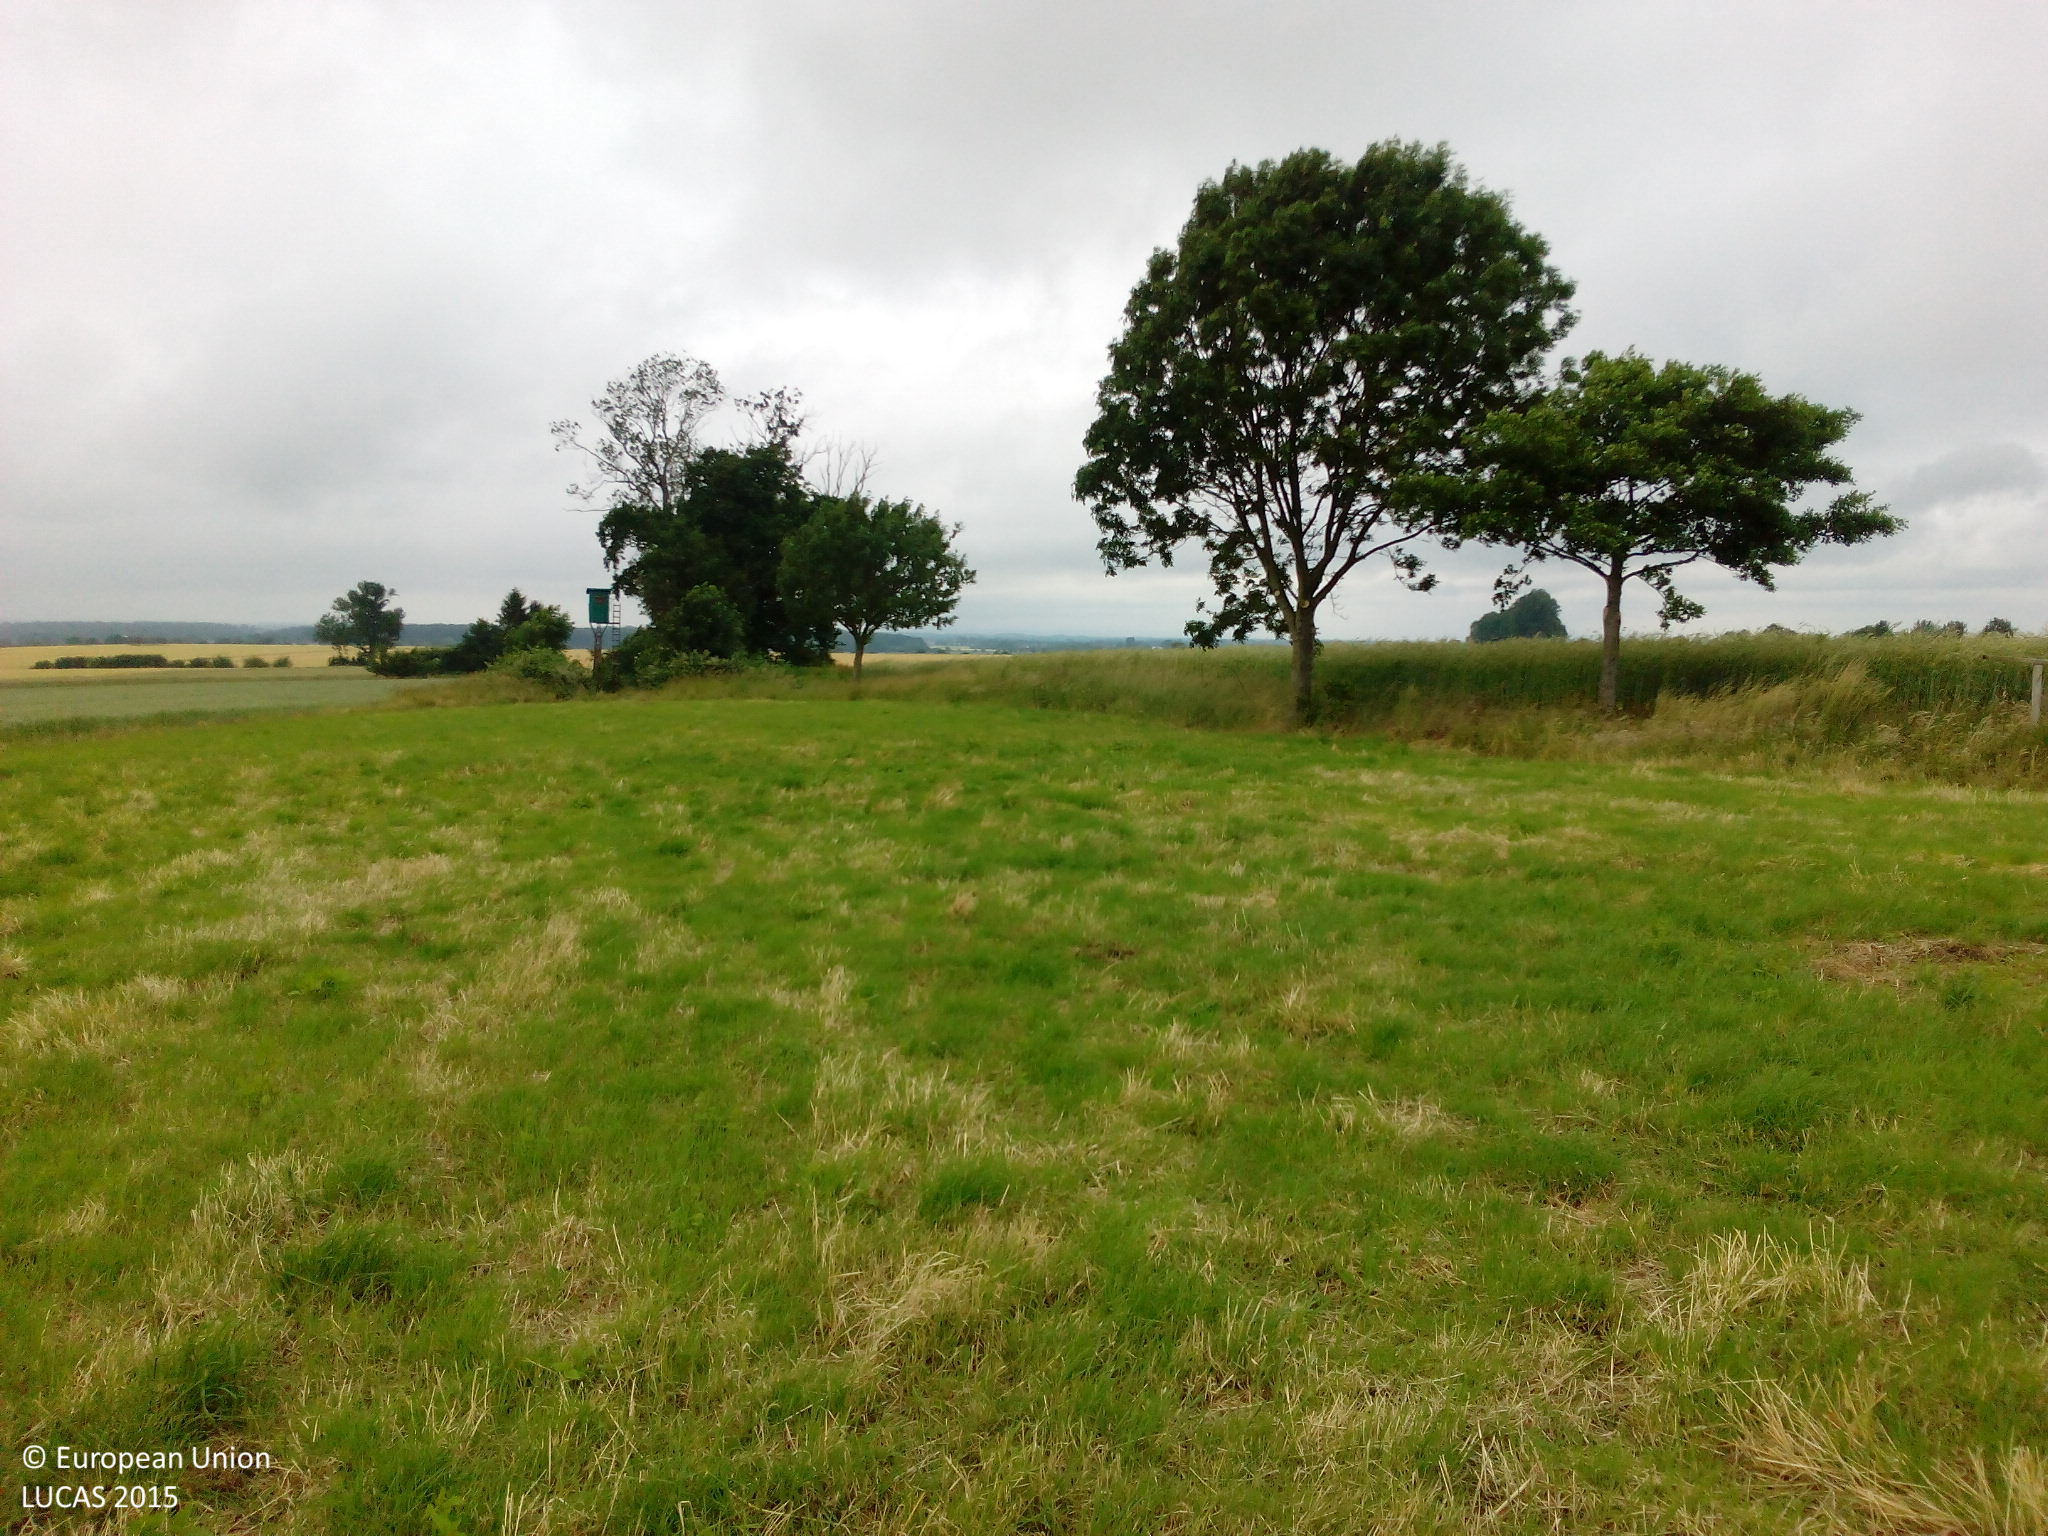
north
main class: Grassland
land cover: Grassland without tree/shrub cover
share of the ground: > 75 %
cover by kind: herbaceous plants 100 %
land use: Agriculture (excluding fallow land and kitchen gardens)
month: June
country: DE
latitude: 51.6318
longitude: 8.5701
